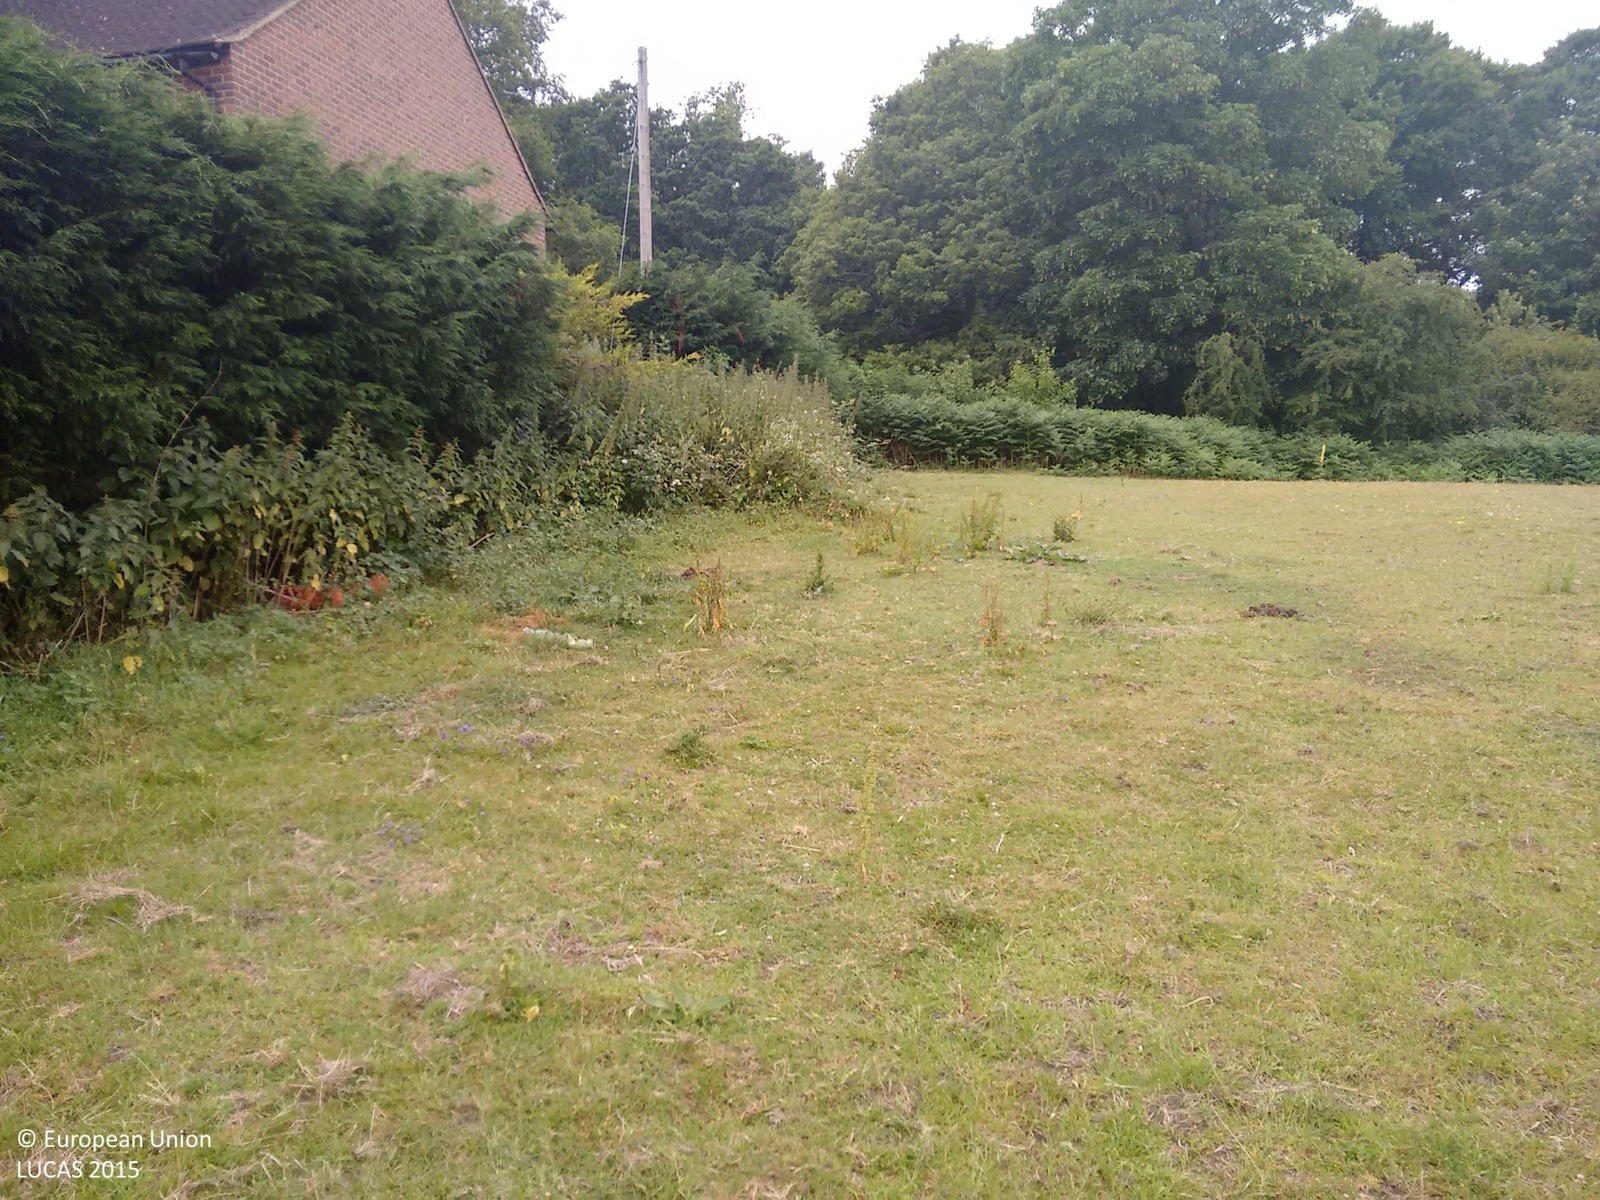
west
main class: Grassland
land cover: Grassland without tree/shrub cover
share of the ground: > 75 %
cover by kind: herbaceous plants 100 %
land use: Agriculture (excluding fallow land and kitchen gardens)
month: July
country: GB
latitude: 50.9189
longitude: -0.4359
